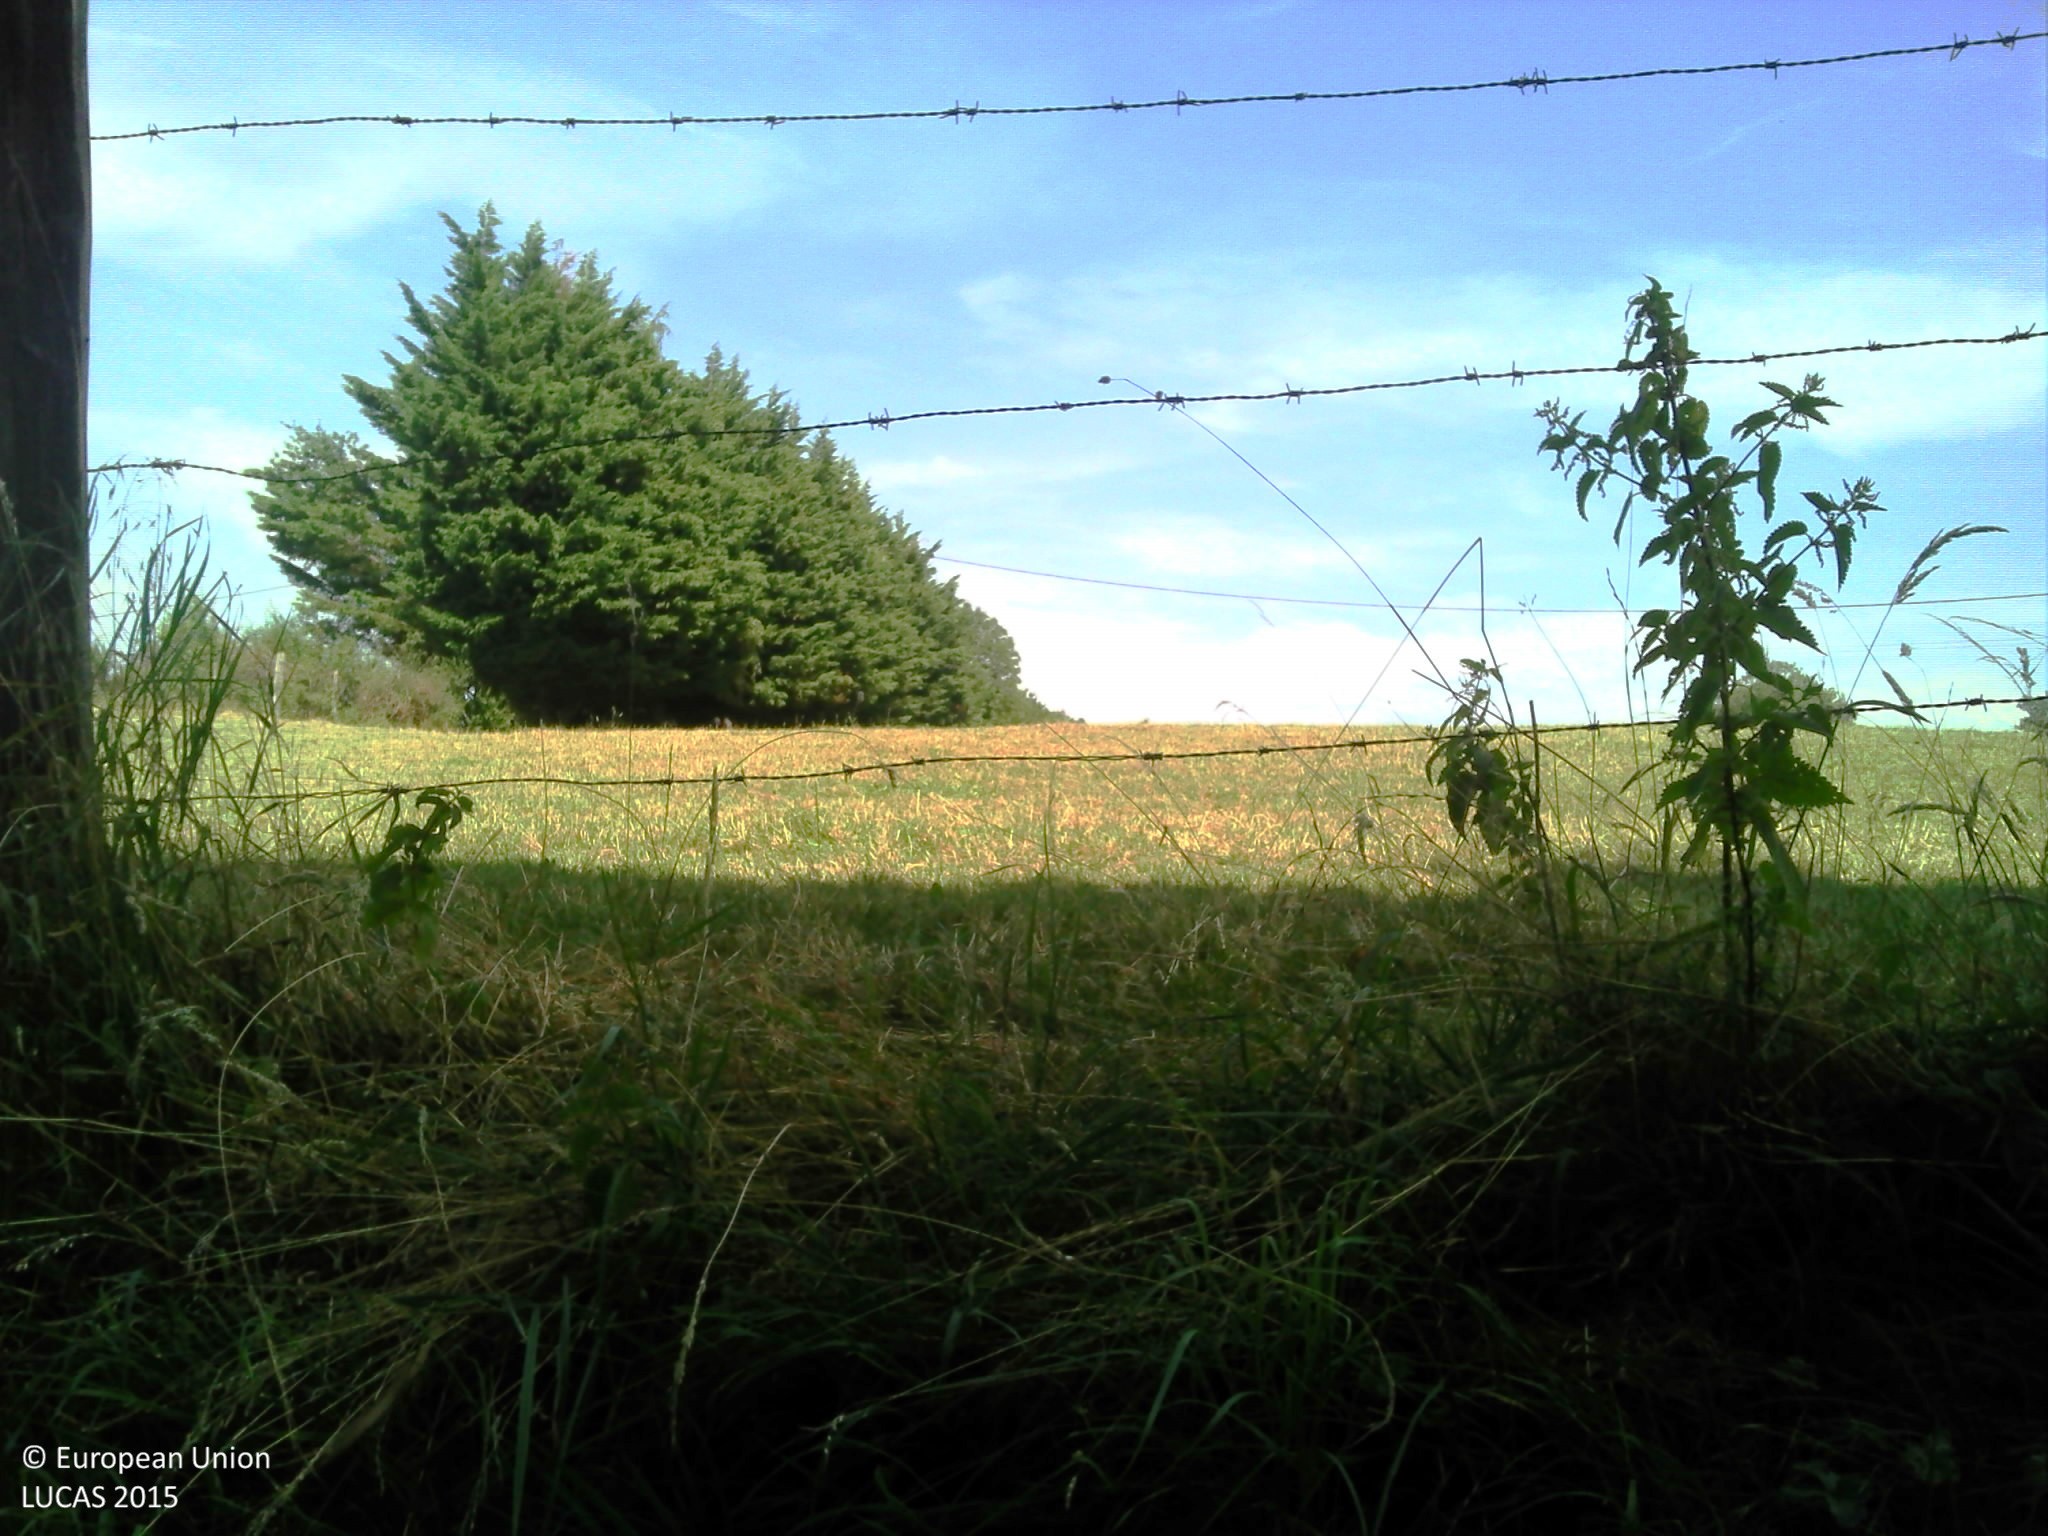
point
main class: Grassland
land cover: Grassland without tree/shrub cover
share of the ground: > 75 %
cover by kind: herbaceous plants 100 %
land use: Agriculture (excluding fallow land and kitchen gardens)
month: July
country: FR
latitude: 45.5286
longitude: 5.3566
